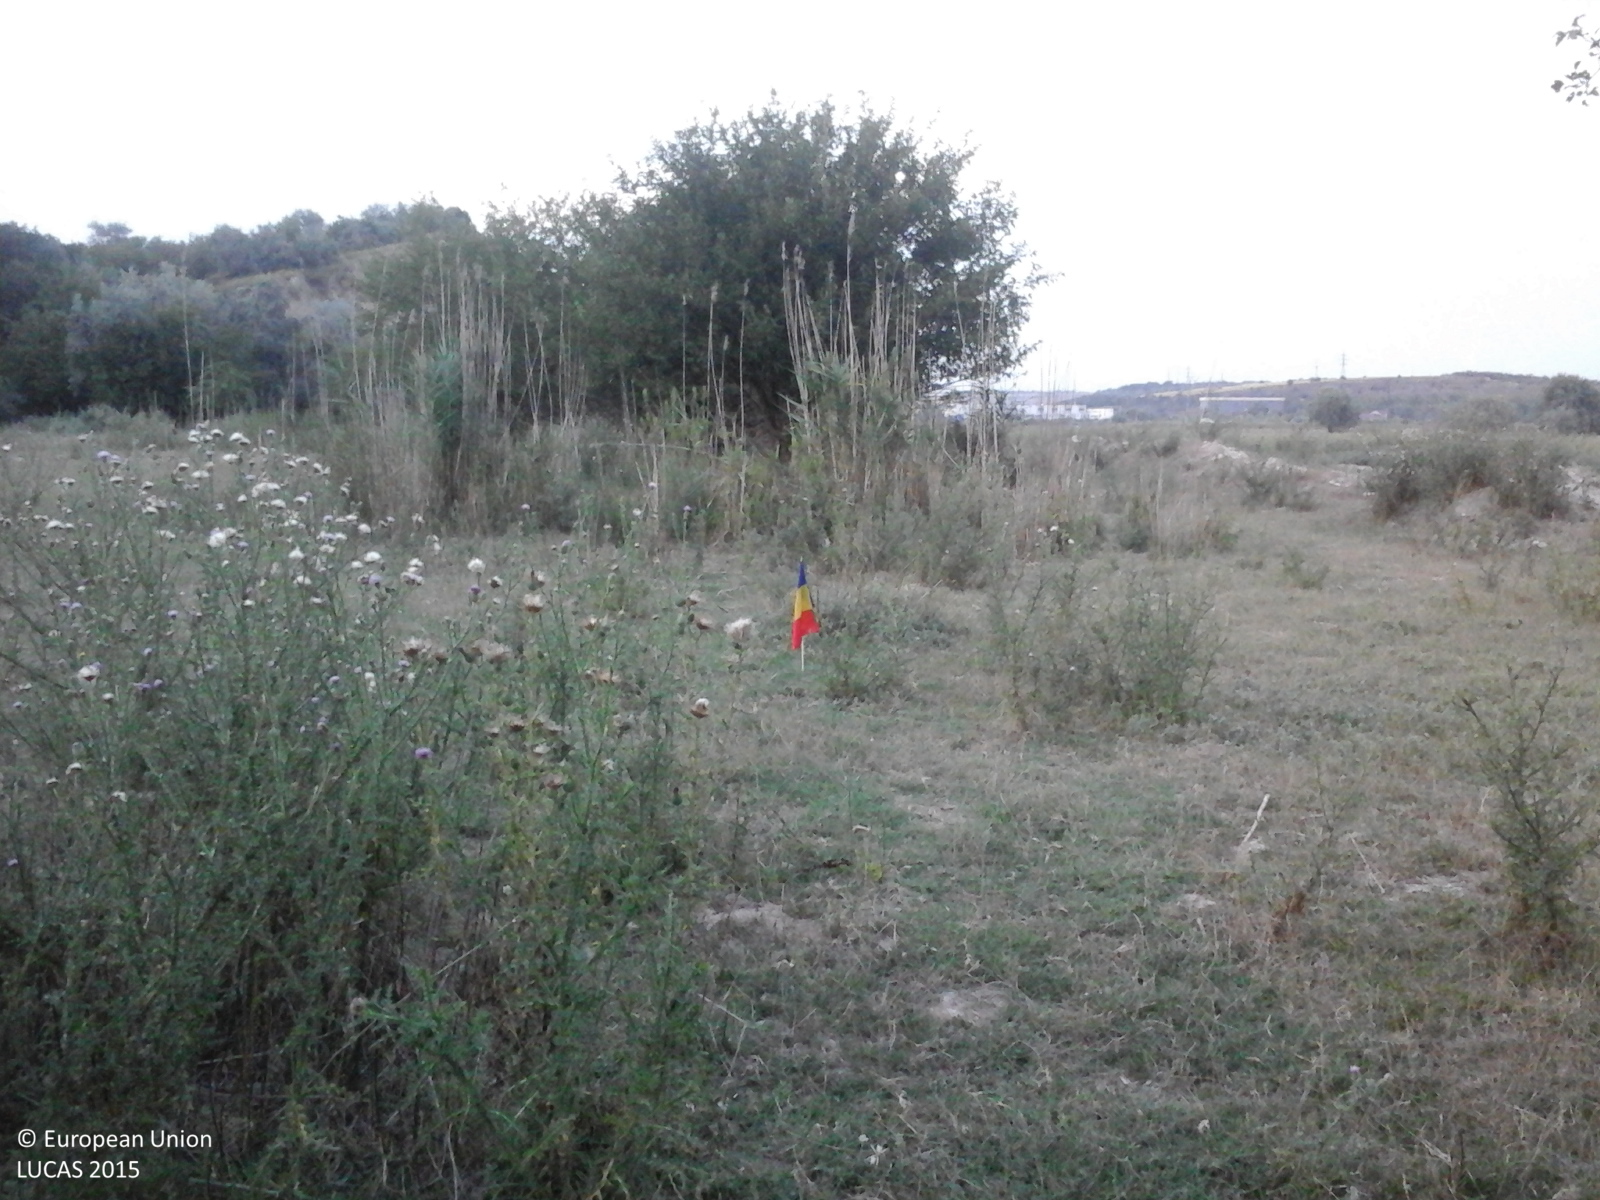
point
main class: Grassland
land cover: Spontaneously vegetated surfaces
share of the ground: > 75 %
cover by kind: herbaceous plants 100 %
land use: Semi-natural and natural areas not in use
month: August
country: RO
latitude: 44.3021
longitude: 28.0438
